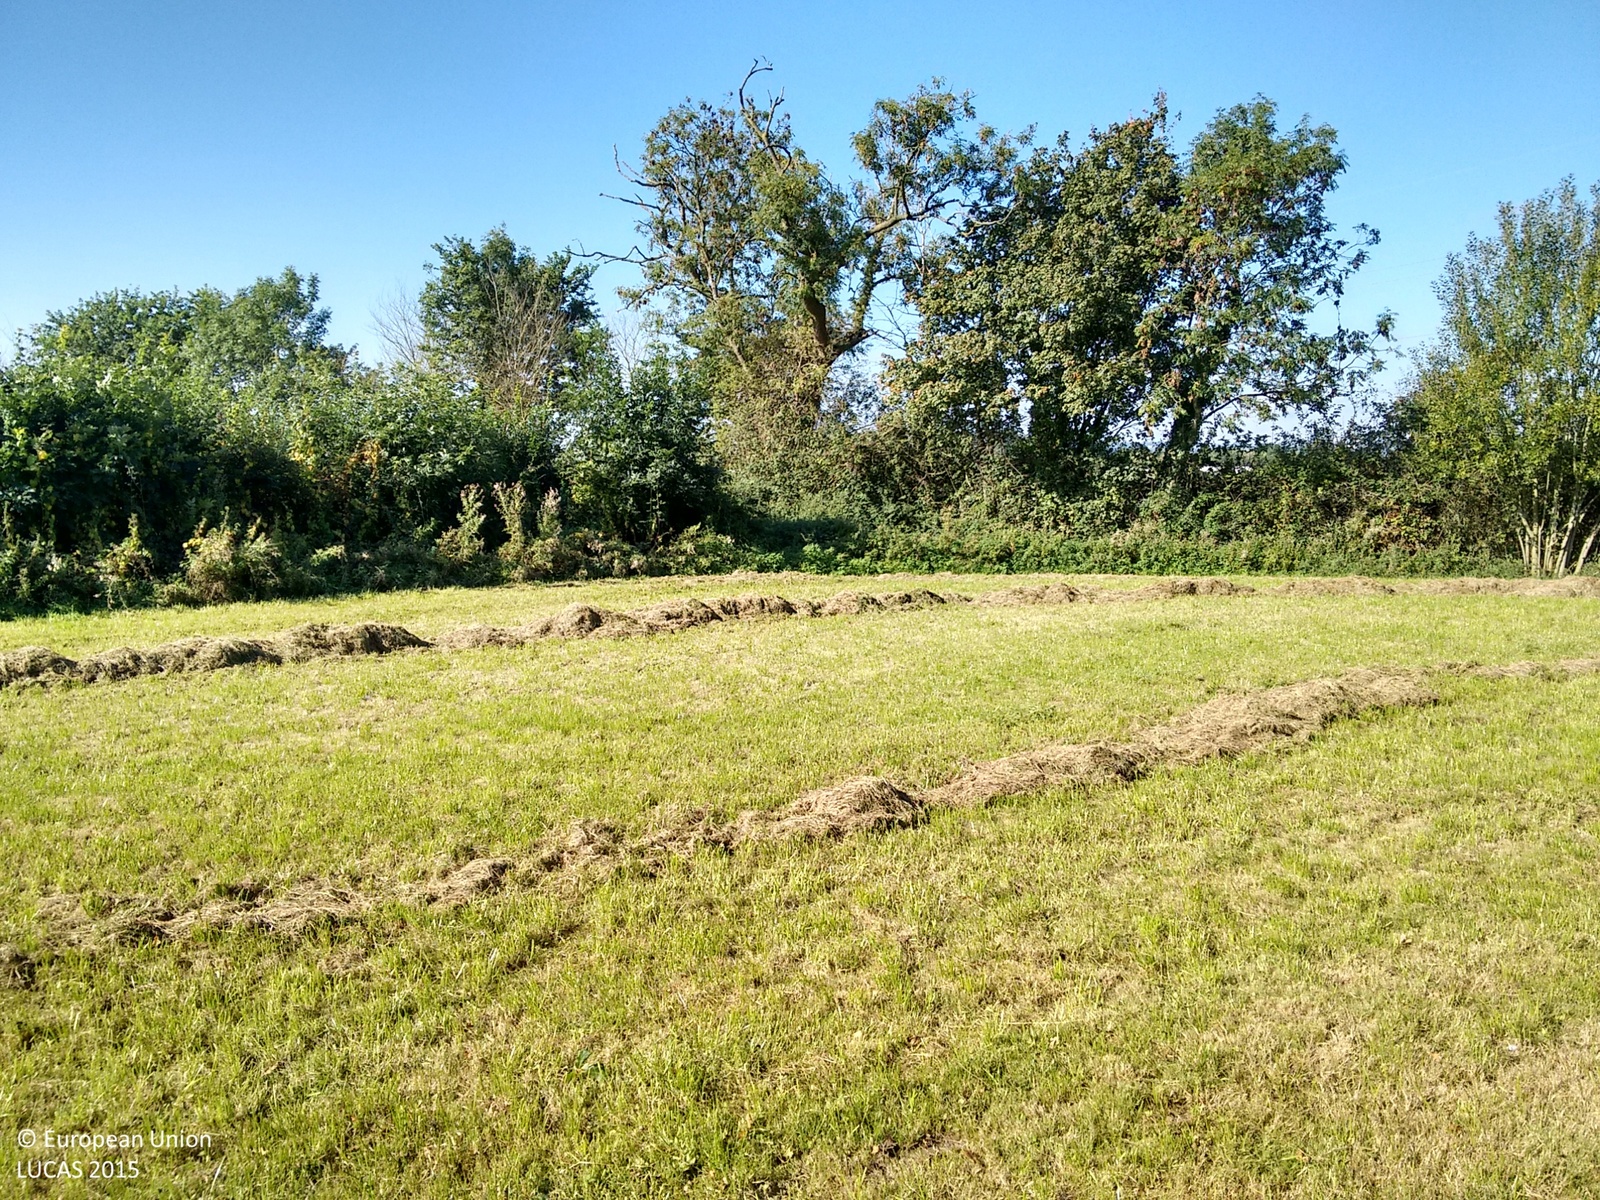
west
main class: Cropland
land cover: Temporary grasslands
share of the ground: > 75 %
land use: Agriculture (excluding fallow land and kitchen gardens)
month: September
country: GB
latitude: 51.7965
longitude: -2.4044
